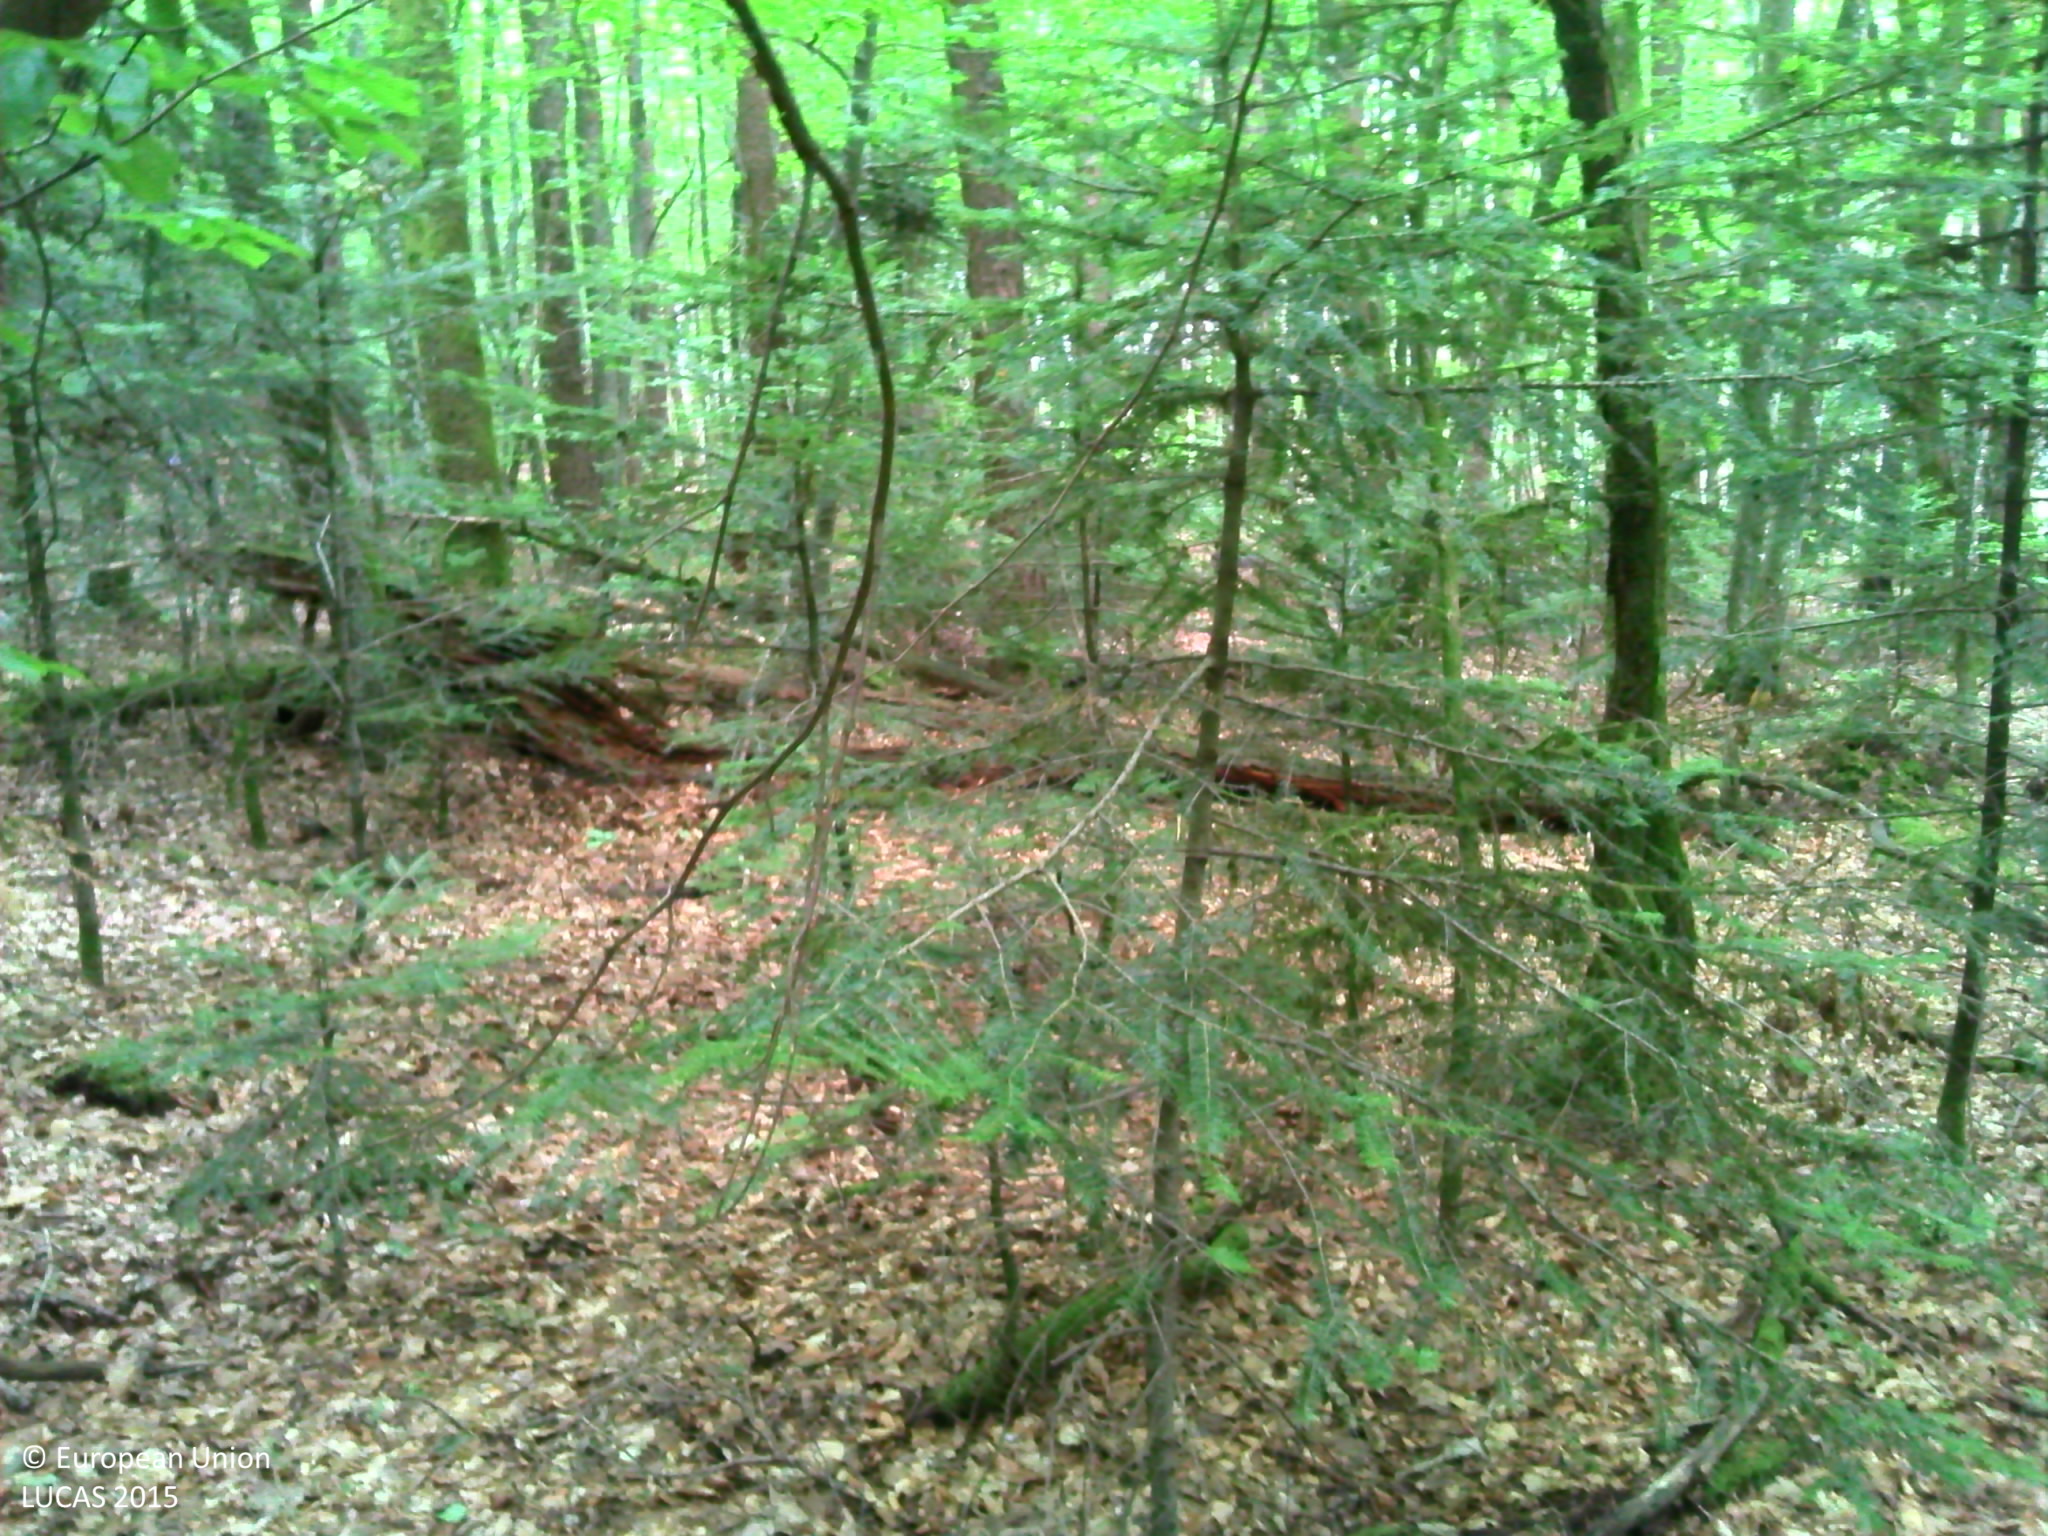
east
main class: Woodland
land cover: Spruce dominated mixed woodland
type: mesophytic deciduous forest
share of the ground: > 75 %
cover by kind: coniferous forest trees 55 %, broadleaved forest trees 25 %, herbaceous plants 10 %
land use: Forestry
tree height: > 5 m
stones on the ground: < 10 %
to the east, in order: Spruce dominated mixed woodland; Tracks; Spruce dominated mixed woodland; Spruce dominated coniferous woodland; Tracks; Spruce dominated coniferous woodland; Spruce dominated mixed woodland; Fences; Grassland without tree/shrub cover; Ditches and canals; Paved roads, cycling and walking lanes; Grass margins; Spruce dominated coniferous woodland
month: August
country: FR
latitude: 46.2247
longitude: 4.4399
